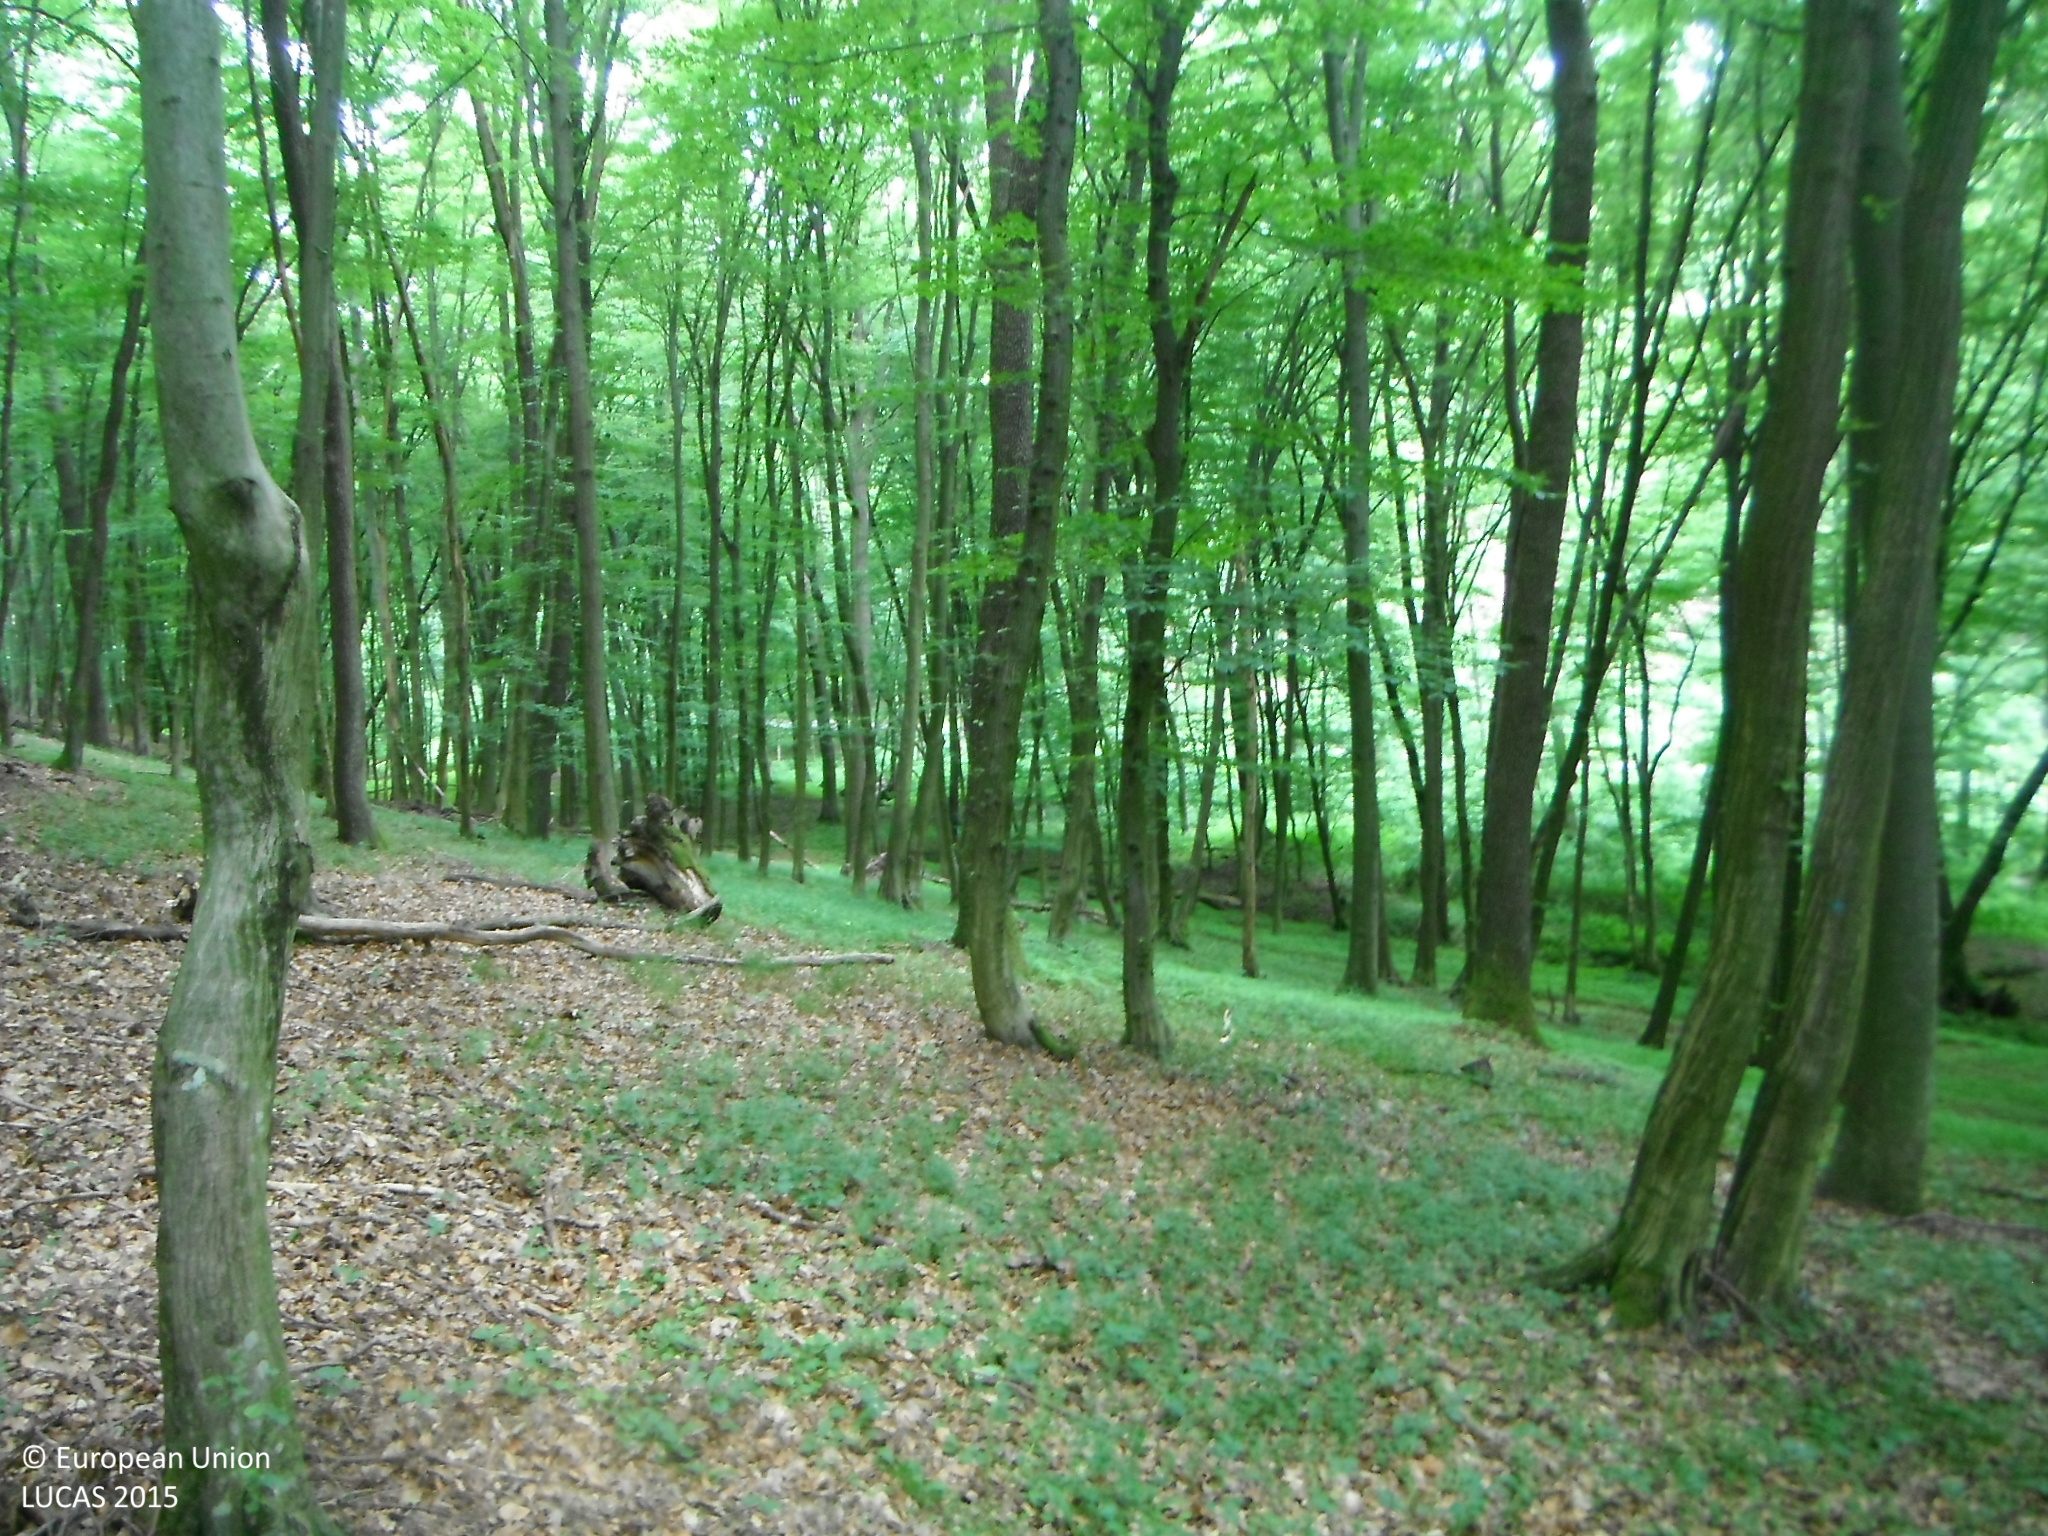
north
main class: Woodland
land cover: Broadleaved woodland
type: mesophytic deciduous forest
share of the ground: > 75 %
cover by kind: broadleaved forest trees 100 %
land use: Forestry
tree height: > 5 m
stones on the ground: < 10 %
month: June
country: SK
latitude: 48.4704
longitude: 18.3068
